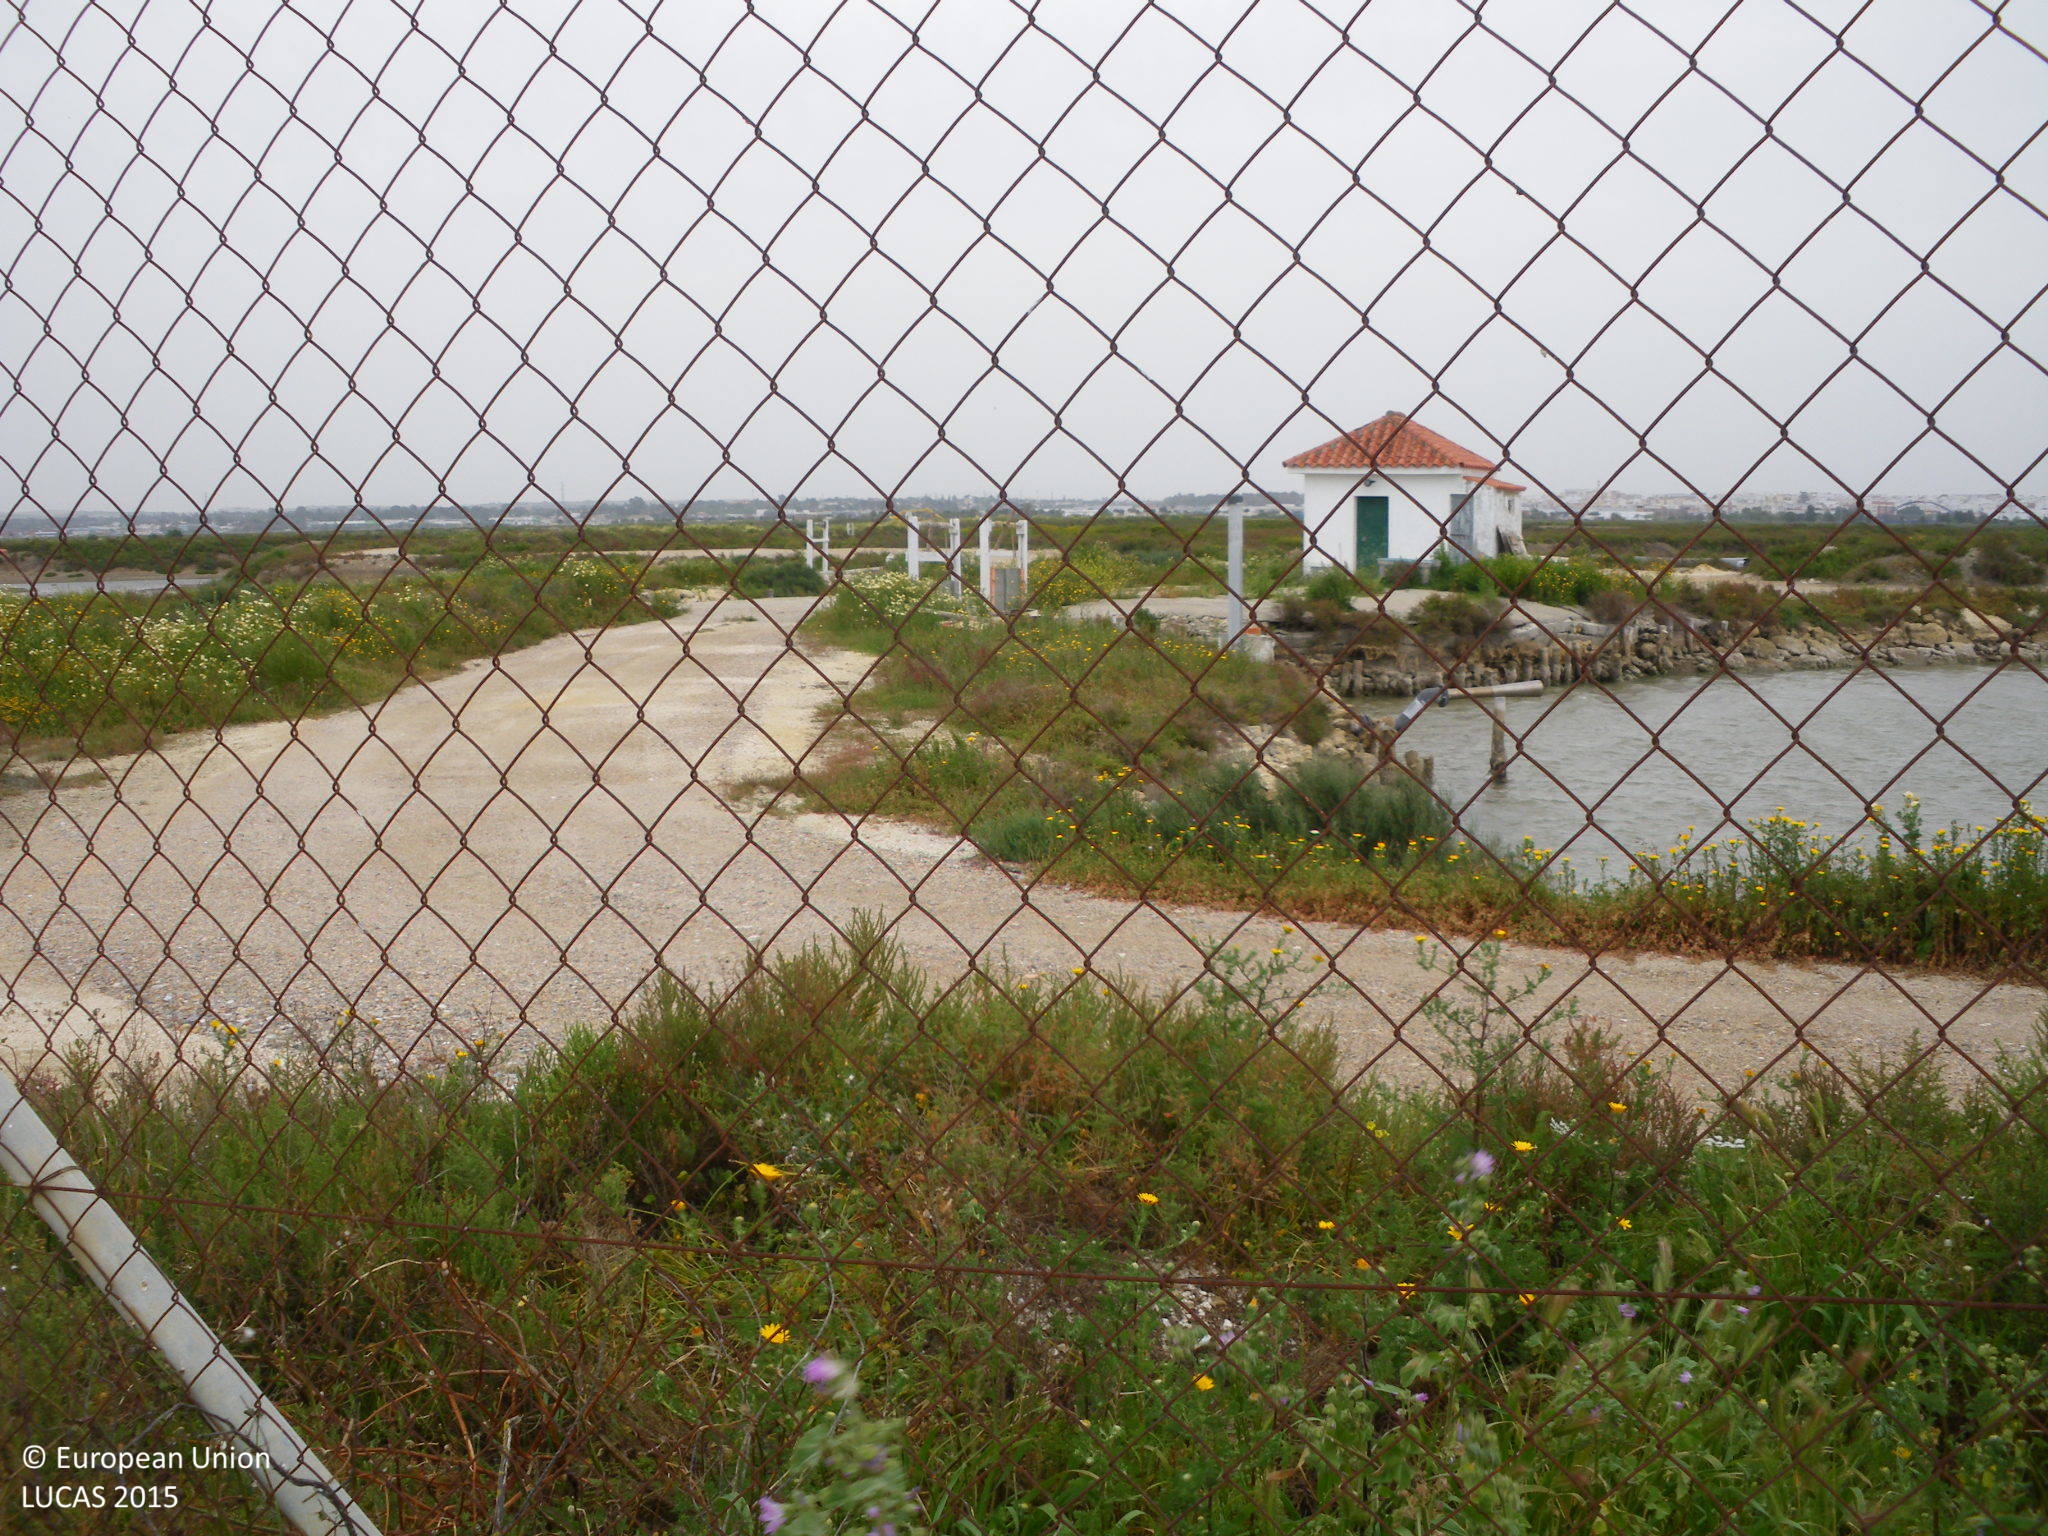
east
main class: Shrubland
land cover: Shrubland without tree cover
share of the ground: > 75 %
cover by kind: shrubs 80 %, unconsolidated bare surface 15 %, herbaceous plants 5 %
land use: Semi-natural and natural areas not in use
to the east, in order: Shrubland without tree cover; Inland salty water bodies; Shrubland without tree cover; Inland salty water bodies; Shrubland without tree cover; Inland salty water bodies
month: April
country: ES
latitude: 36.4276
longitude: -6.1696
